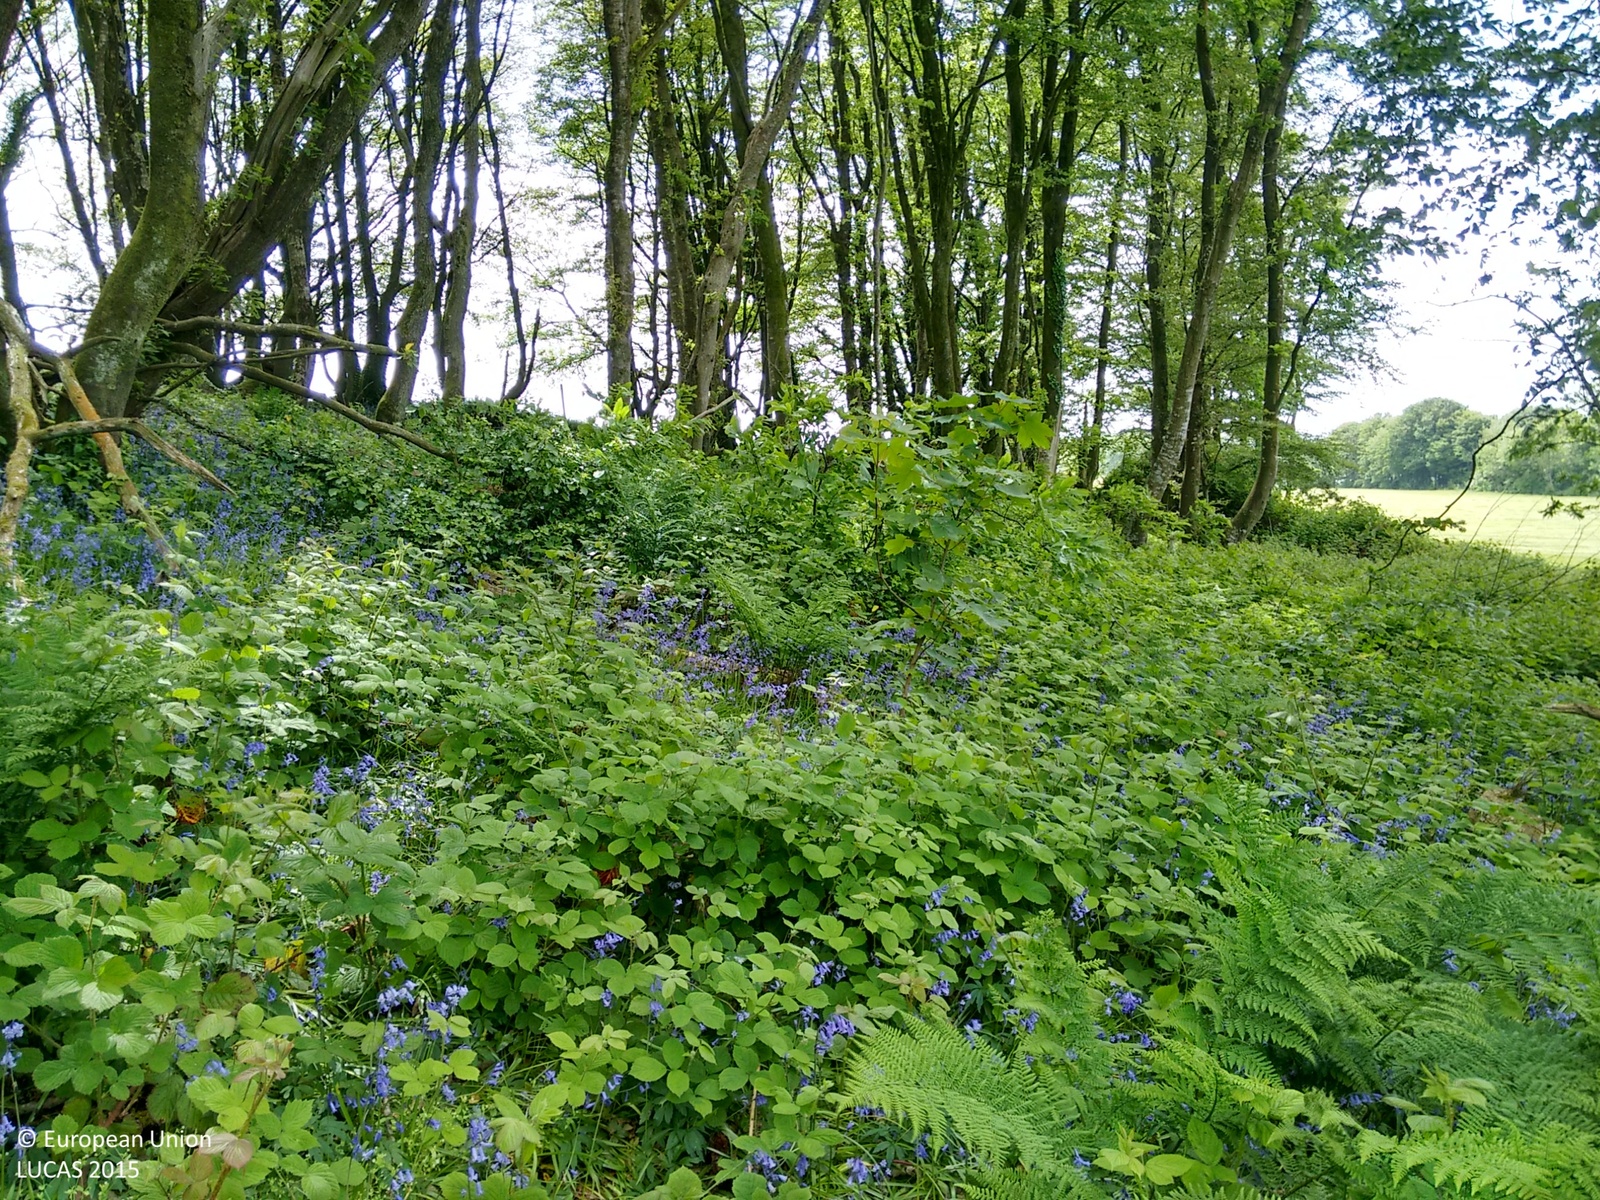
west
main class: Woodland
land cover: Broadleaved woodland
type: mesophytic deciduous forest
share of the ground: > 75 %
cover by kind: broadleaved forest trees 90 %, shrubs 10 %
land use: Semi-natural and natural areas not in use
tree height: > 5 m
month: June
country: IE
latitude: 51.8920
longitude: -8.0959
